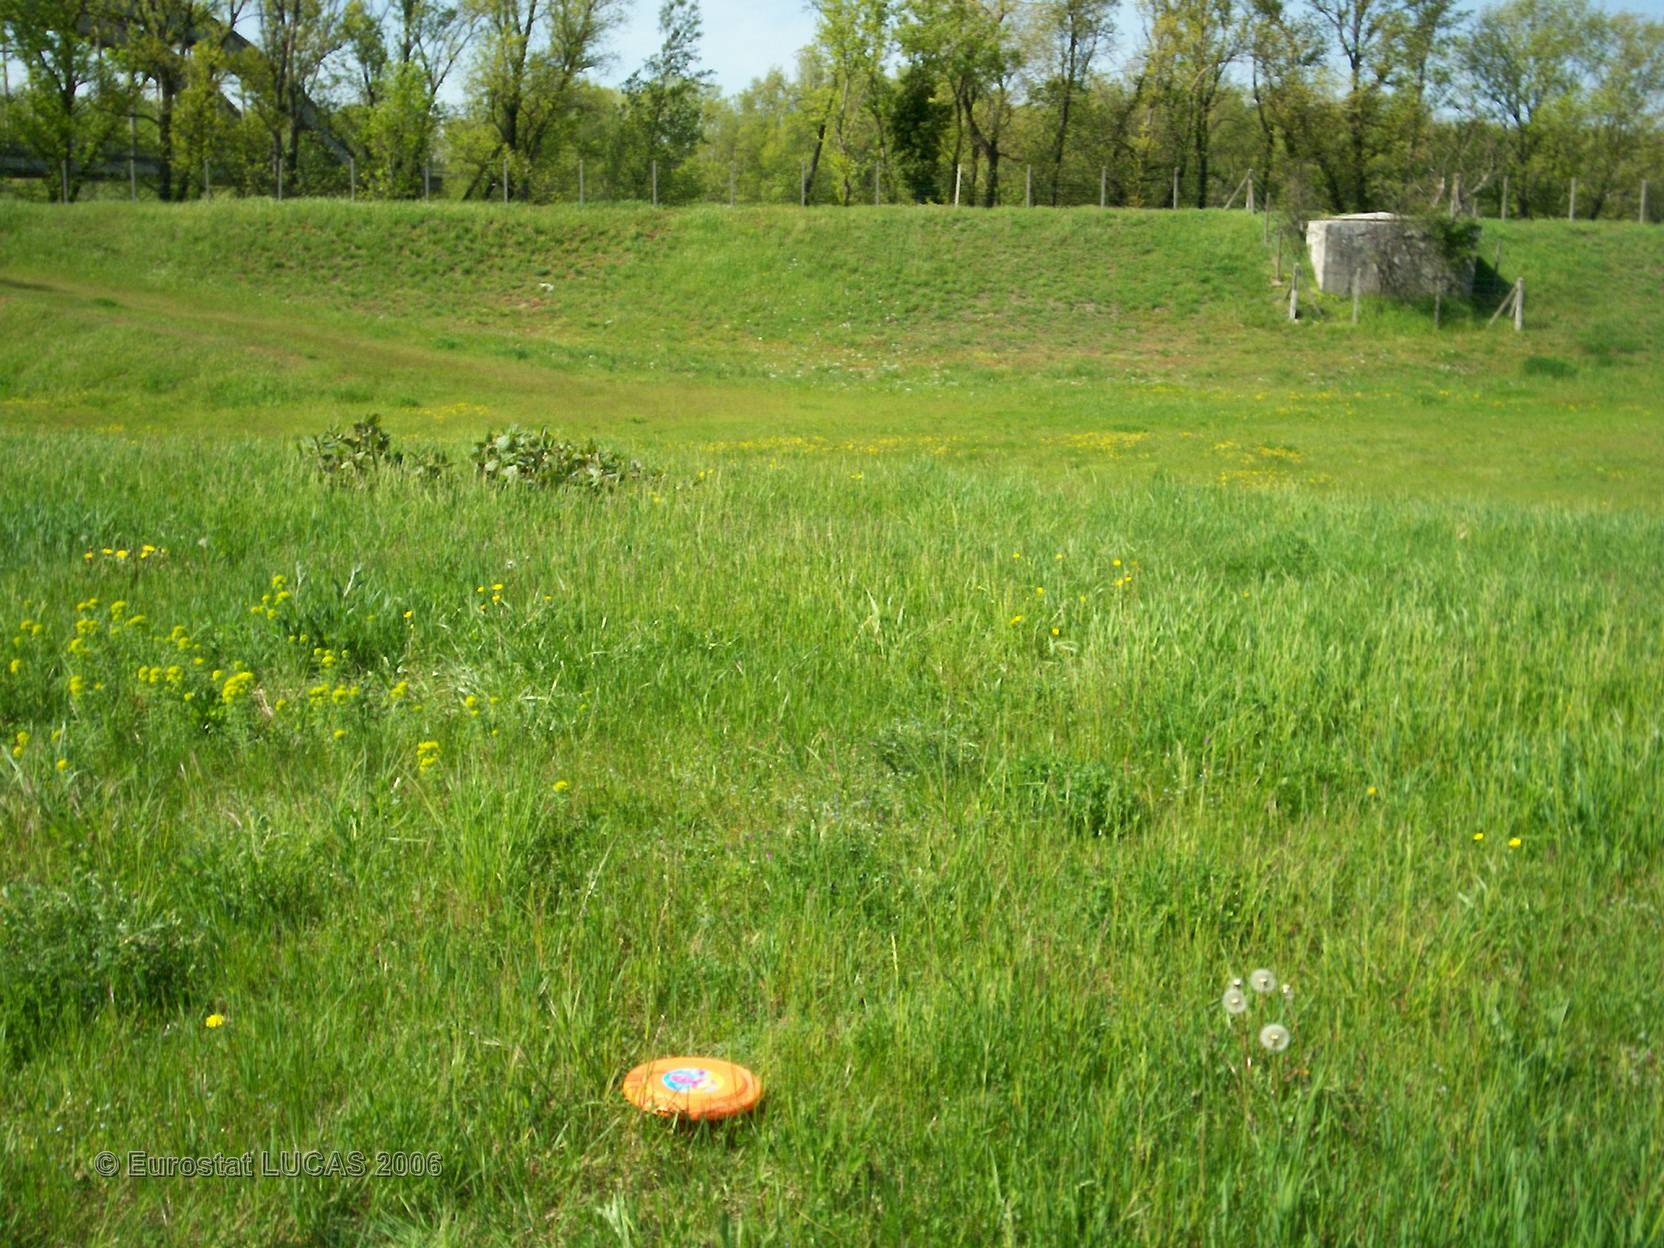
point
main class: Grassland
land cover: Grassland without tree/shrub cover
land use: Road transport
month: April
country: FR
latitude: 45.5923
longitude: 4.7867
